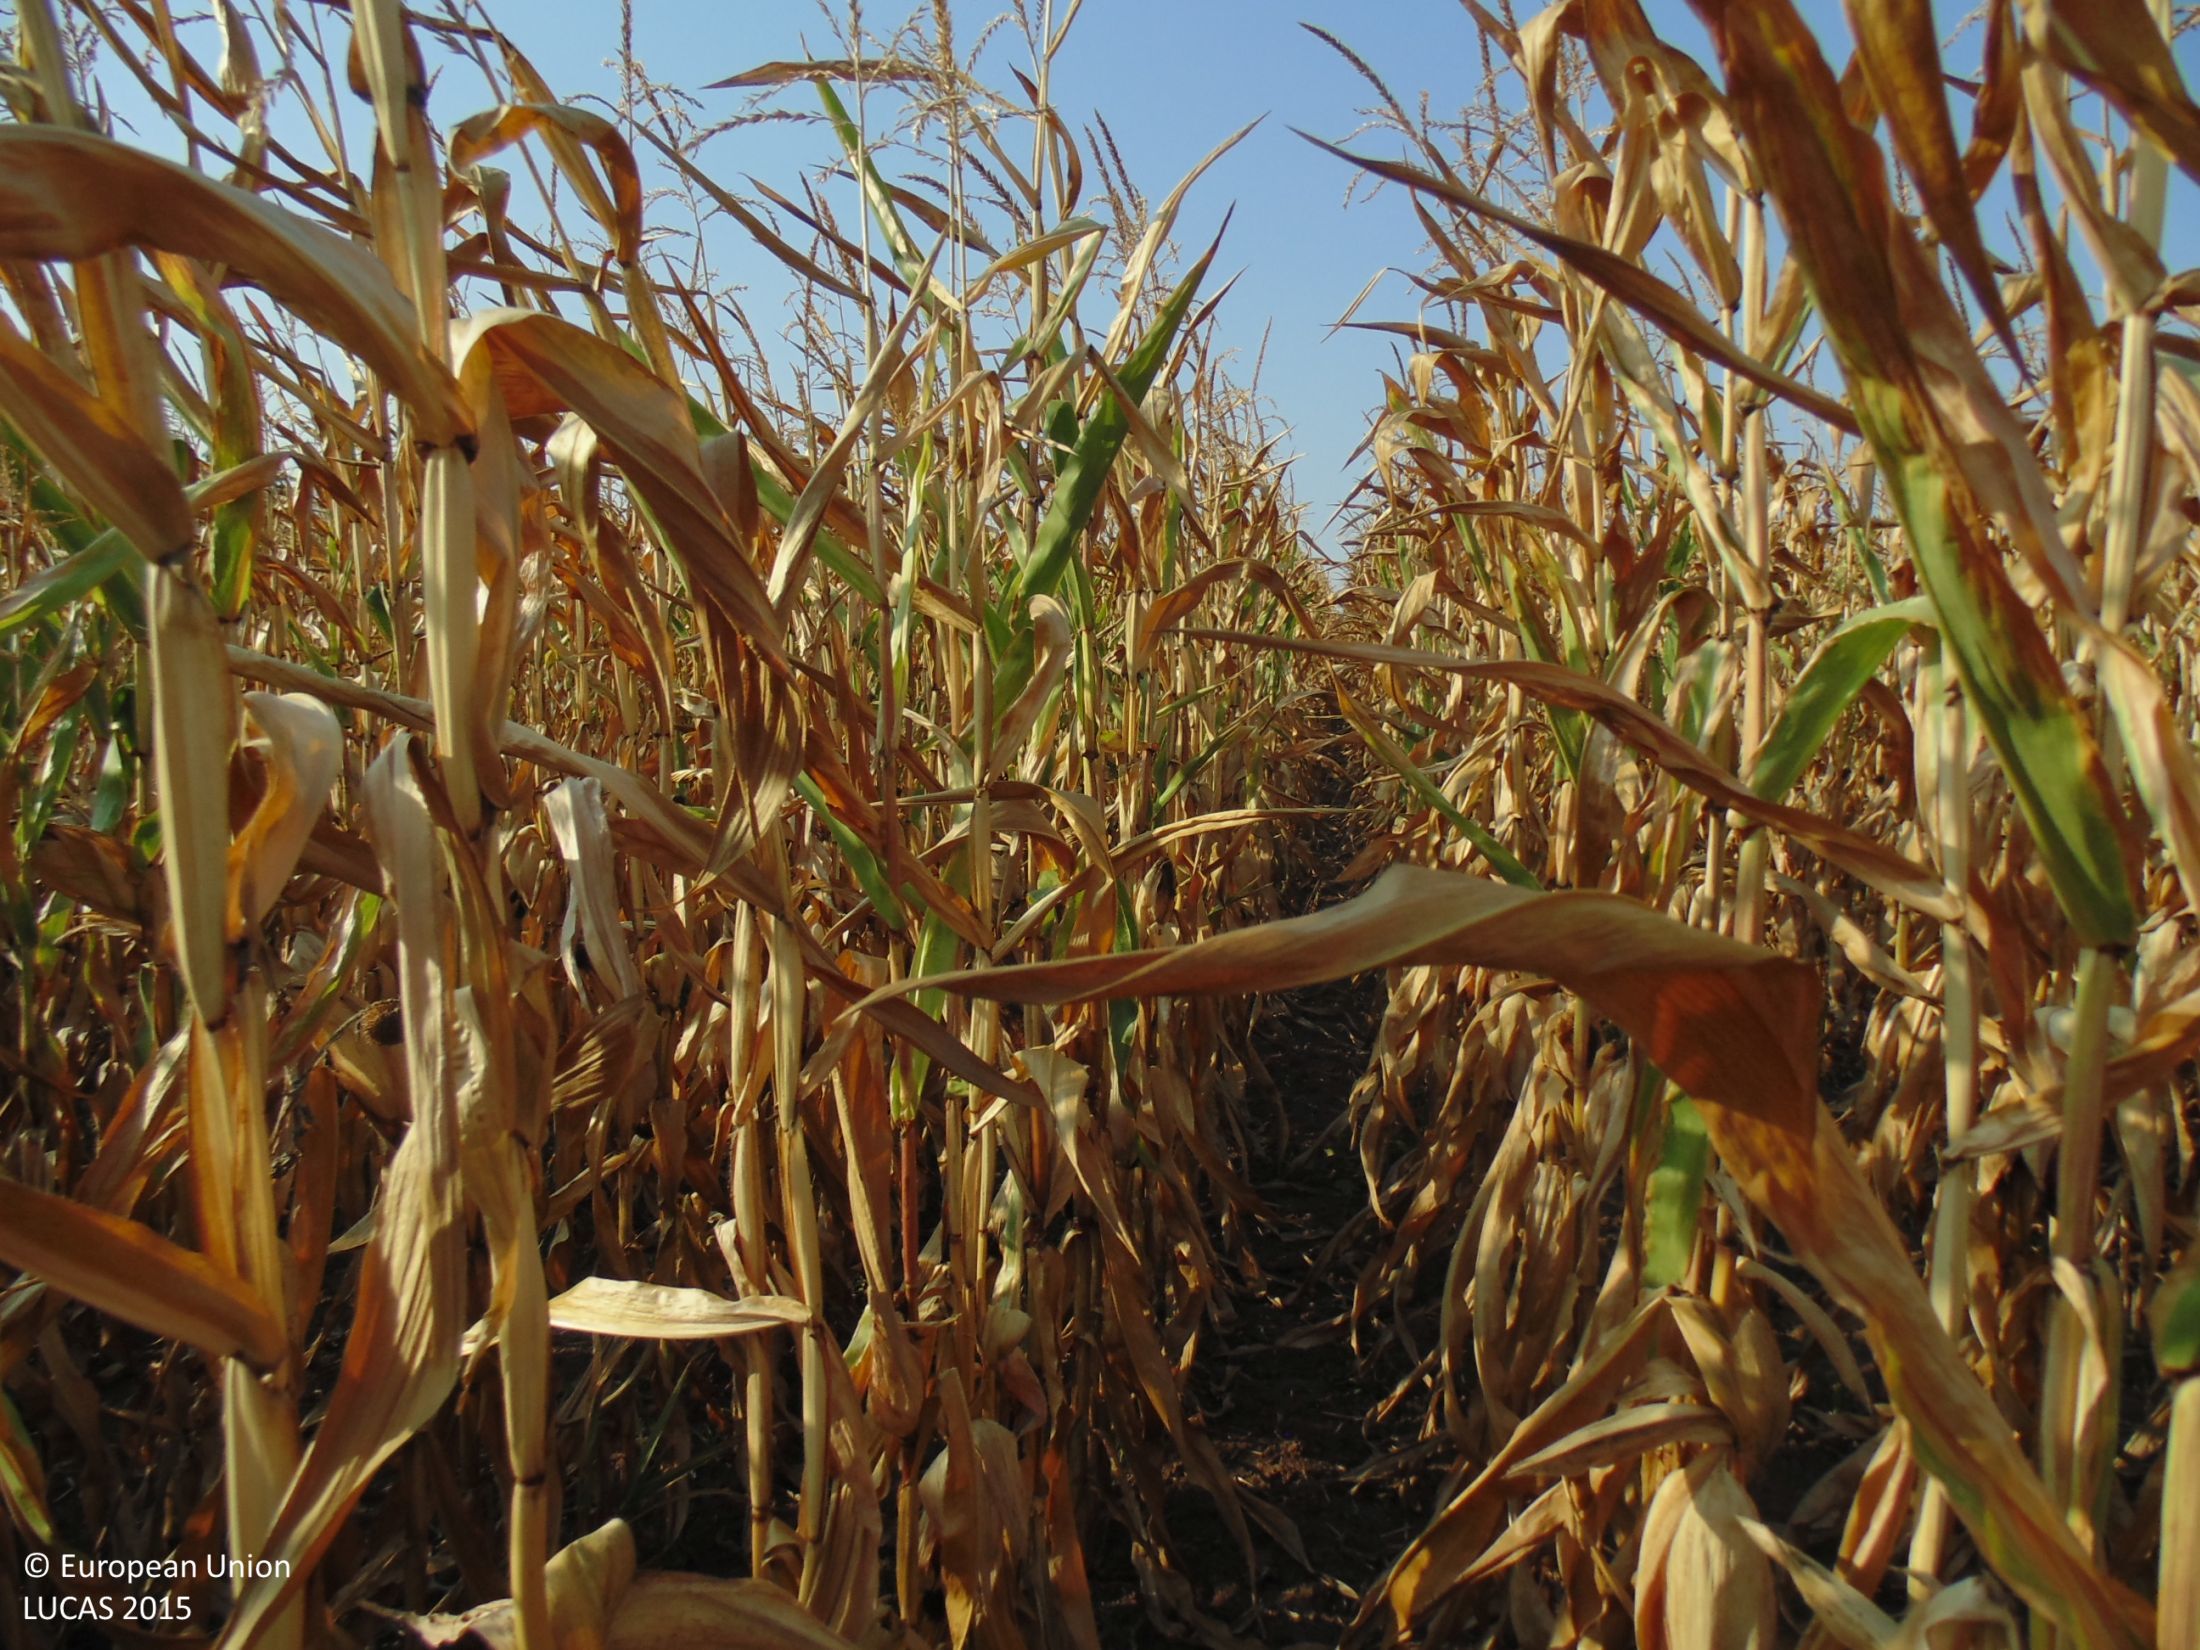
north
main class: Cropland
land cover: Maize
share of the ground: > 75 %
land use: Agriculture (excluding fallow land and kitchen gardens)
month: August
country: BG
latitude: 43.9187
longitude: 27.2789
